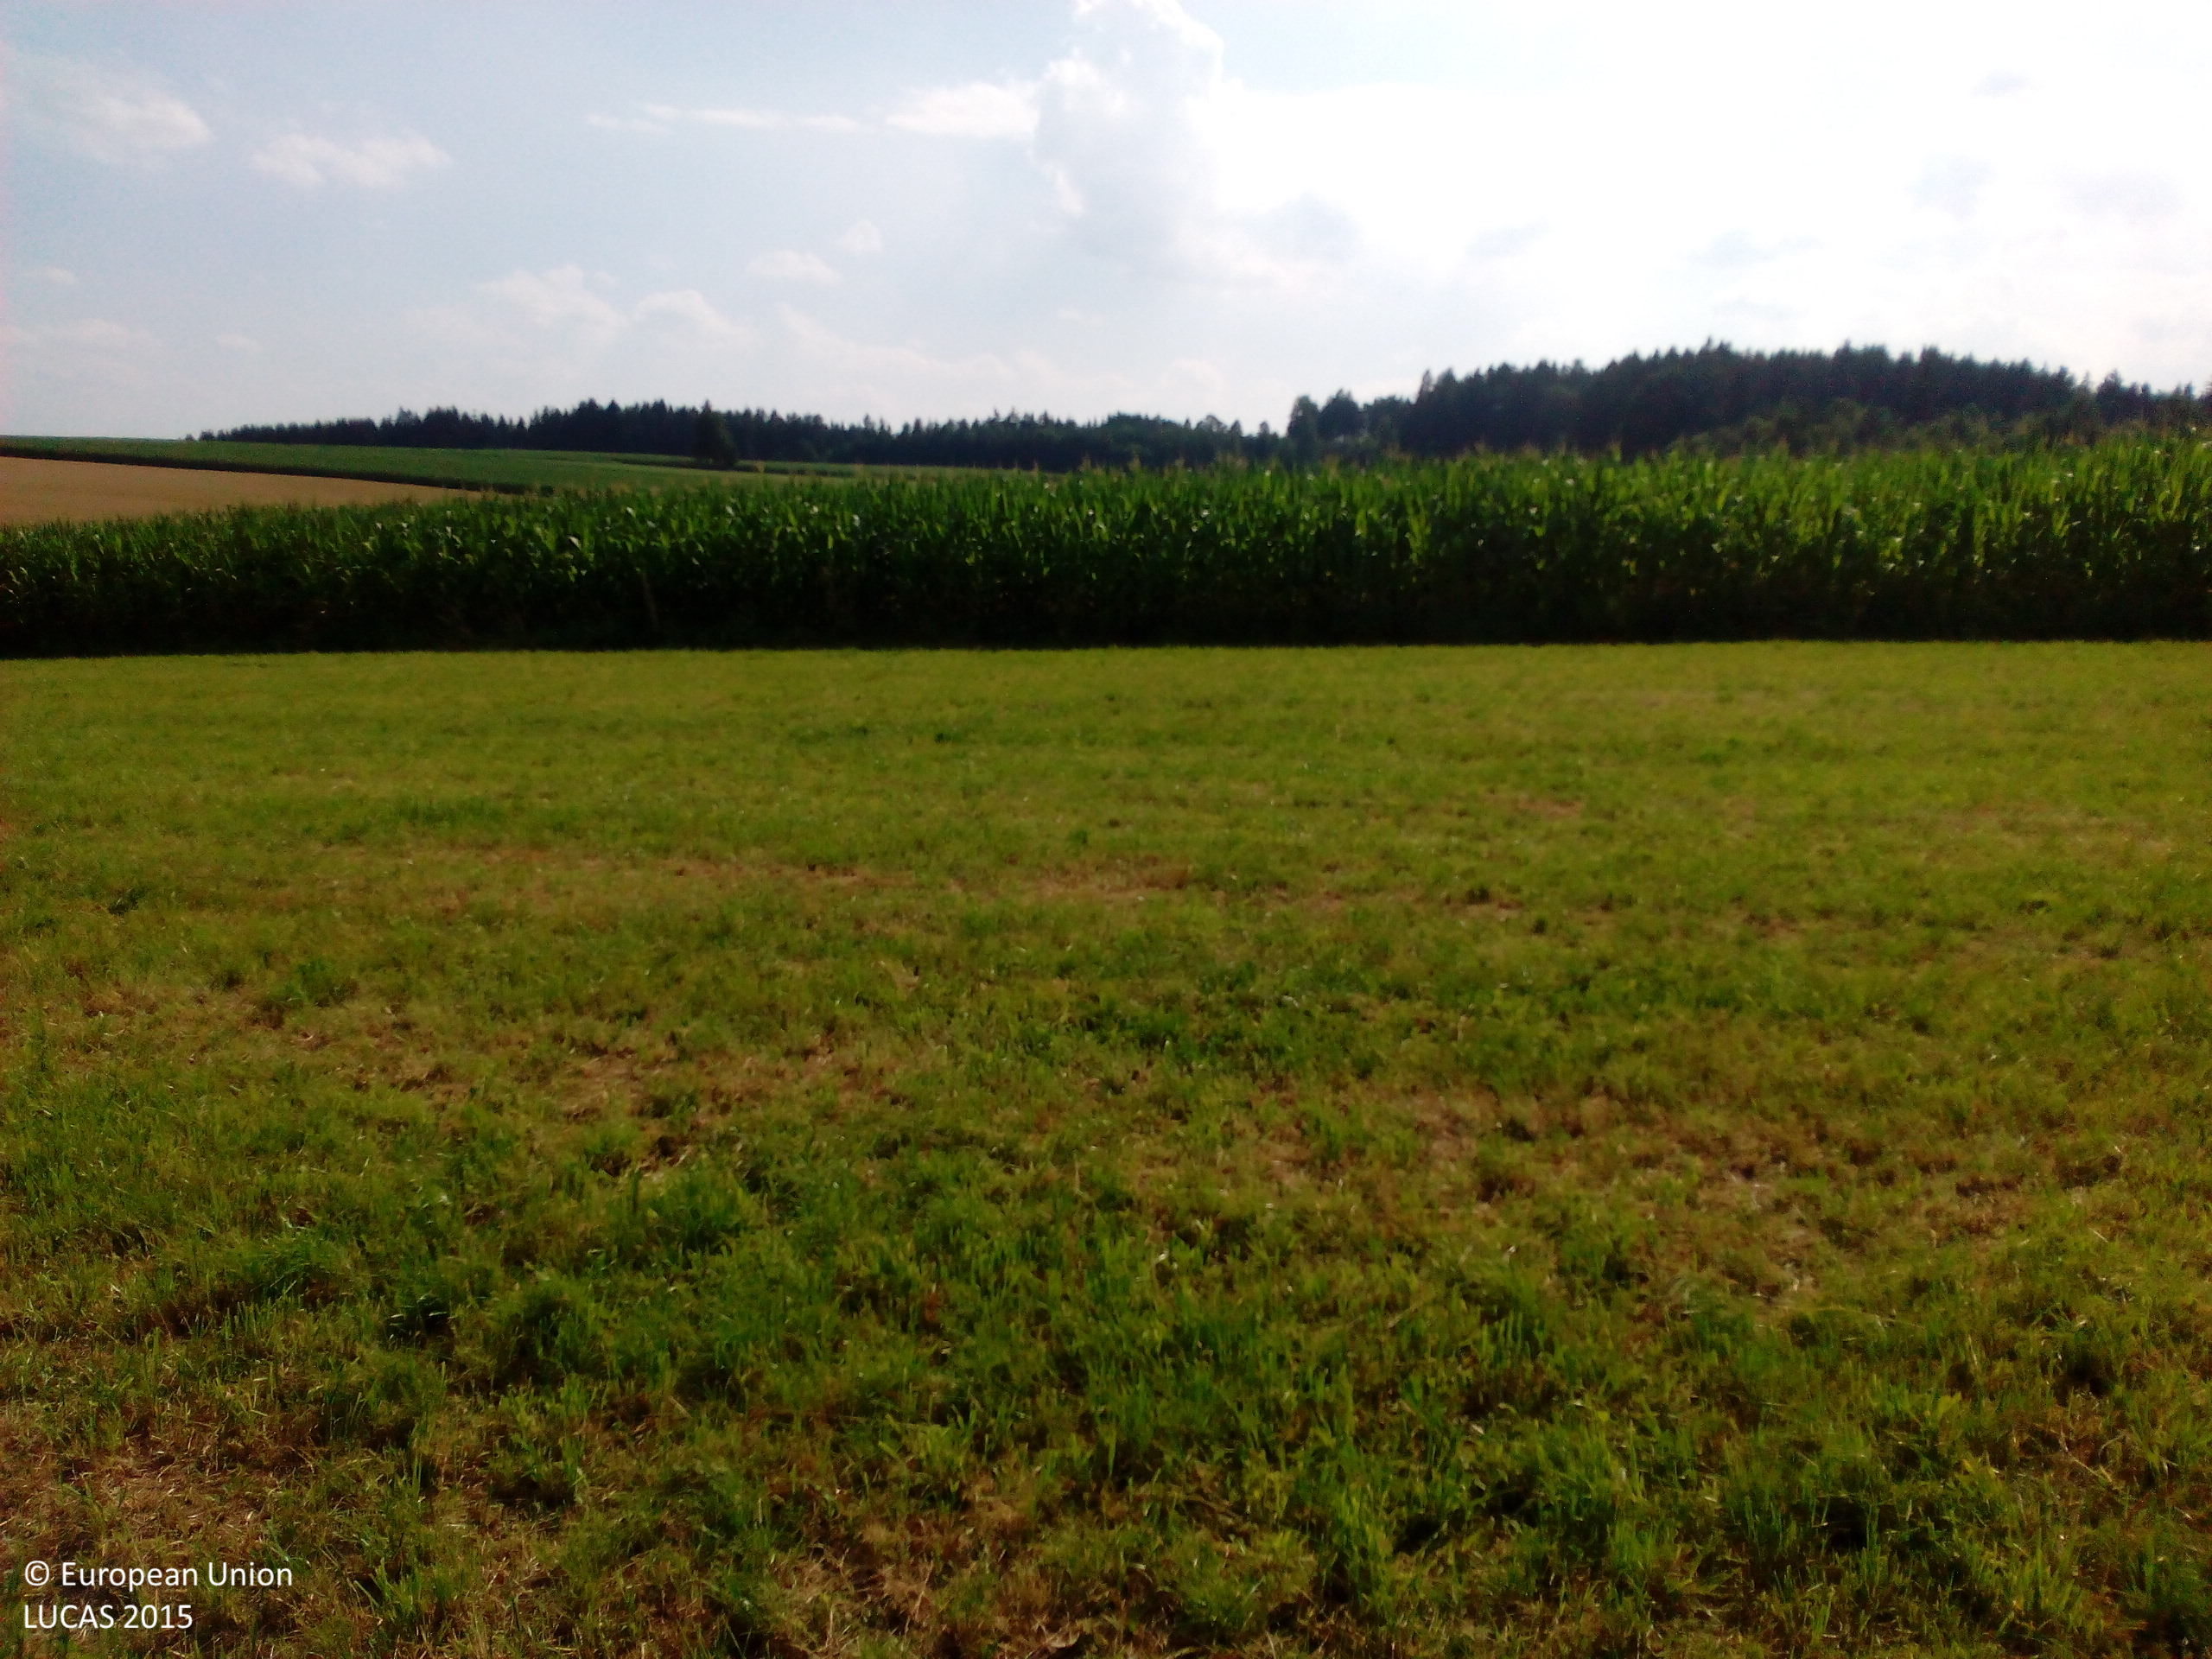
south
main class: Grassland
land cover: Grassland without tree/shrub cover
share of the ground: > 75 %
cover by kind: herbaceous plants 100 %
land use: Agriculture (excluding fallow land and kitchen gardens)
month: July
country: DE
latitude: 48.3834
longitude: 12.9022
